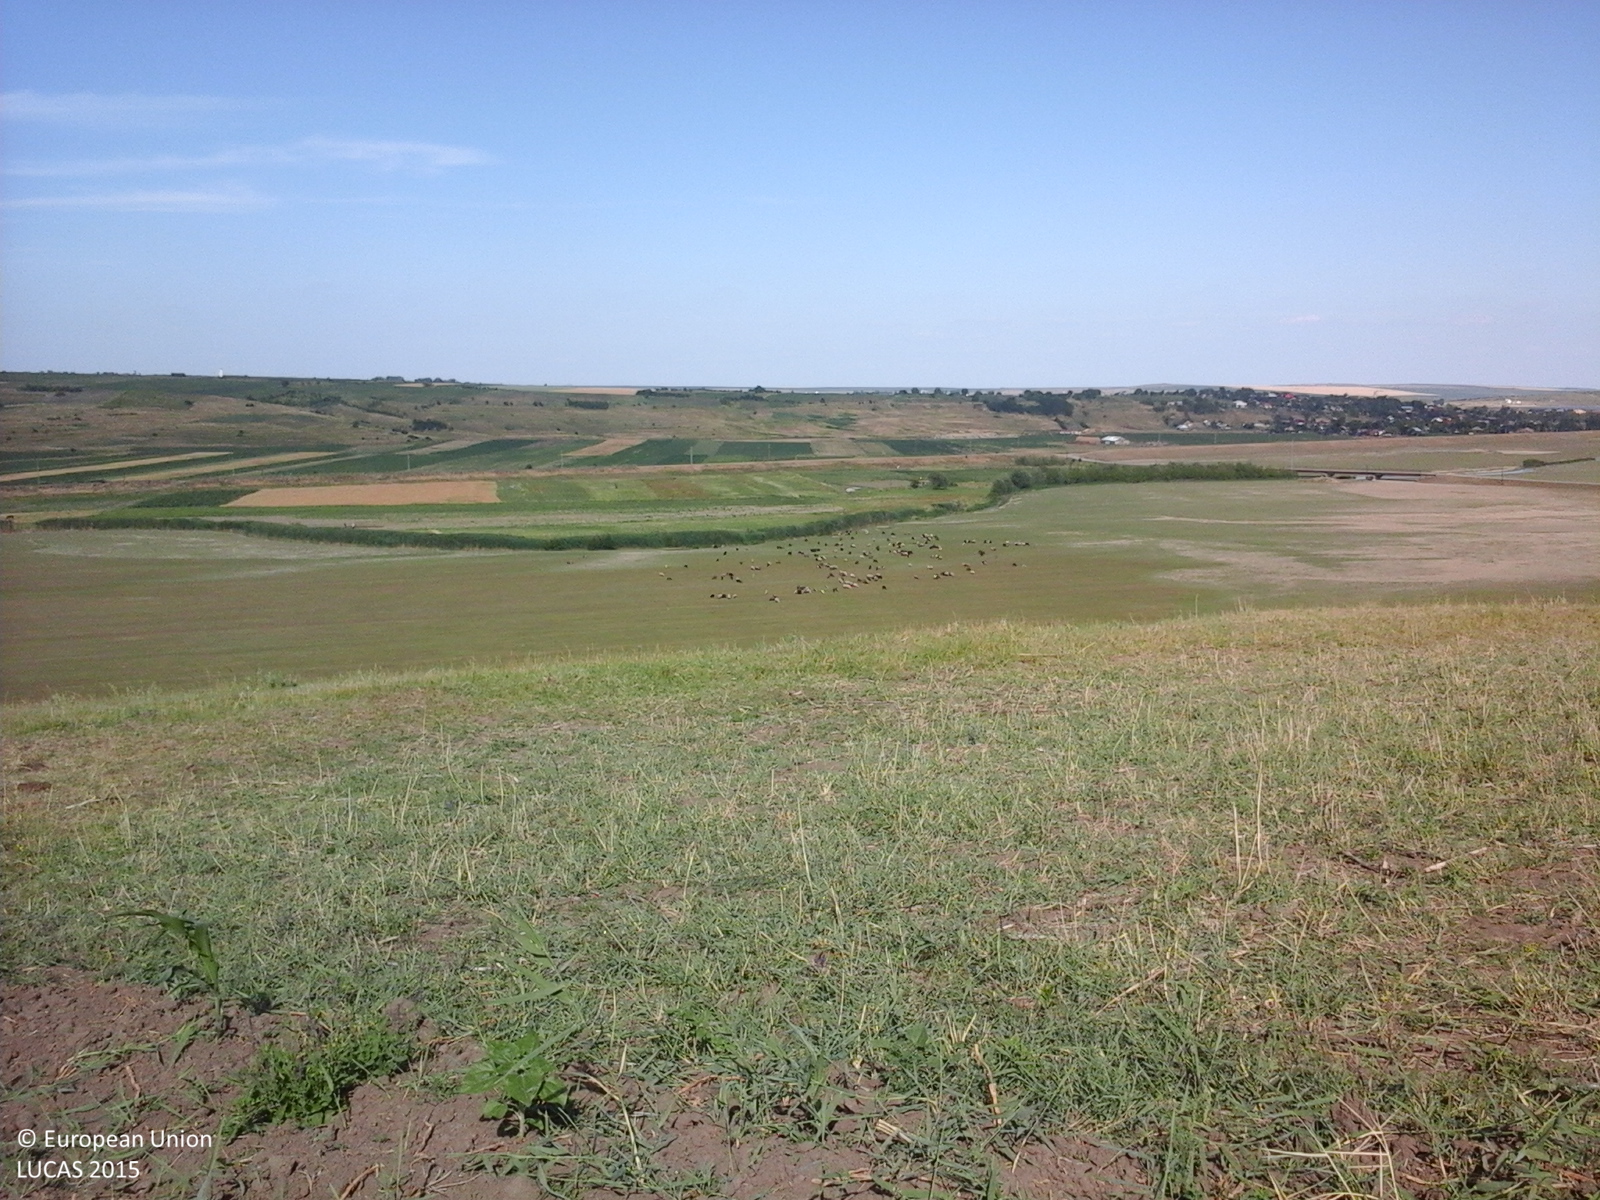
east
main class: Cropland
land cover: Maize
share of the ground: 25 - 50 %
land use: Agriculture (excluding fallow land and kitchen gardens)
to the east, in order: Maize; Grassland without tree/shrub cover
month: June
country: RO
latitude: 47.3056
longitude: 27.0464
